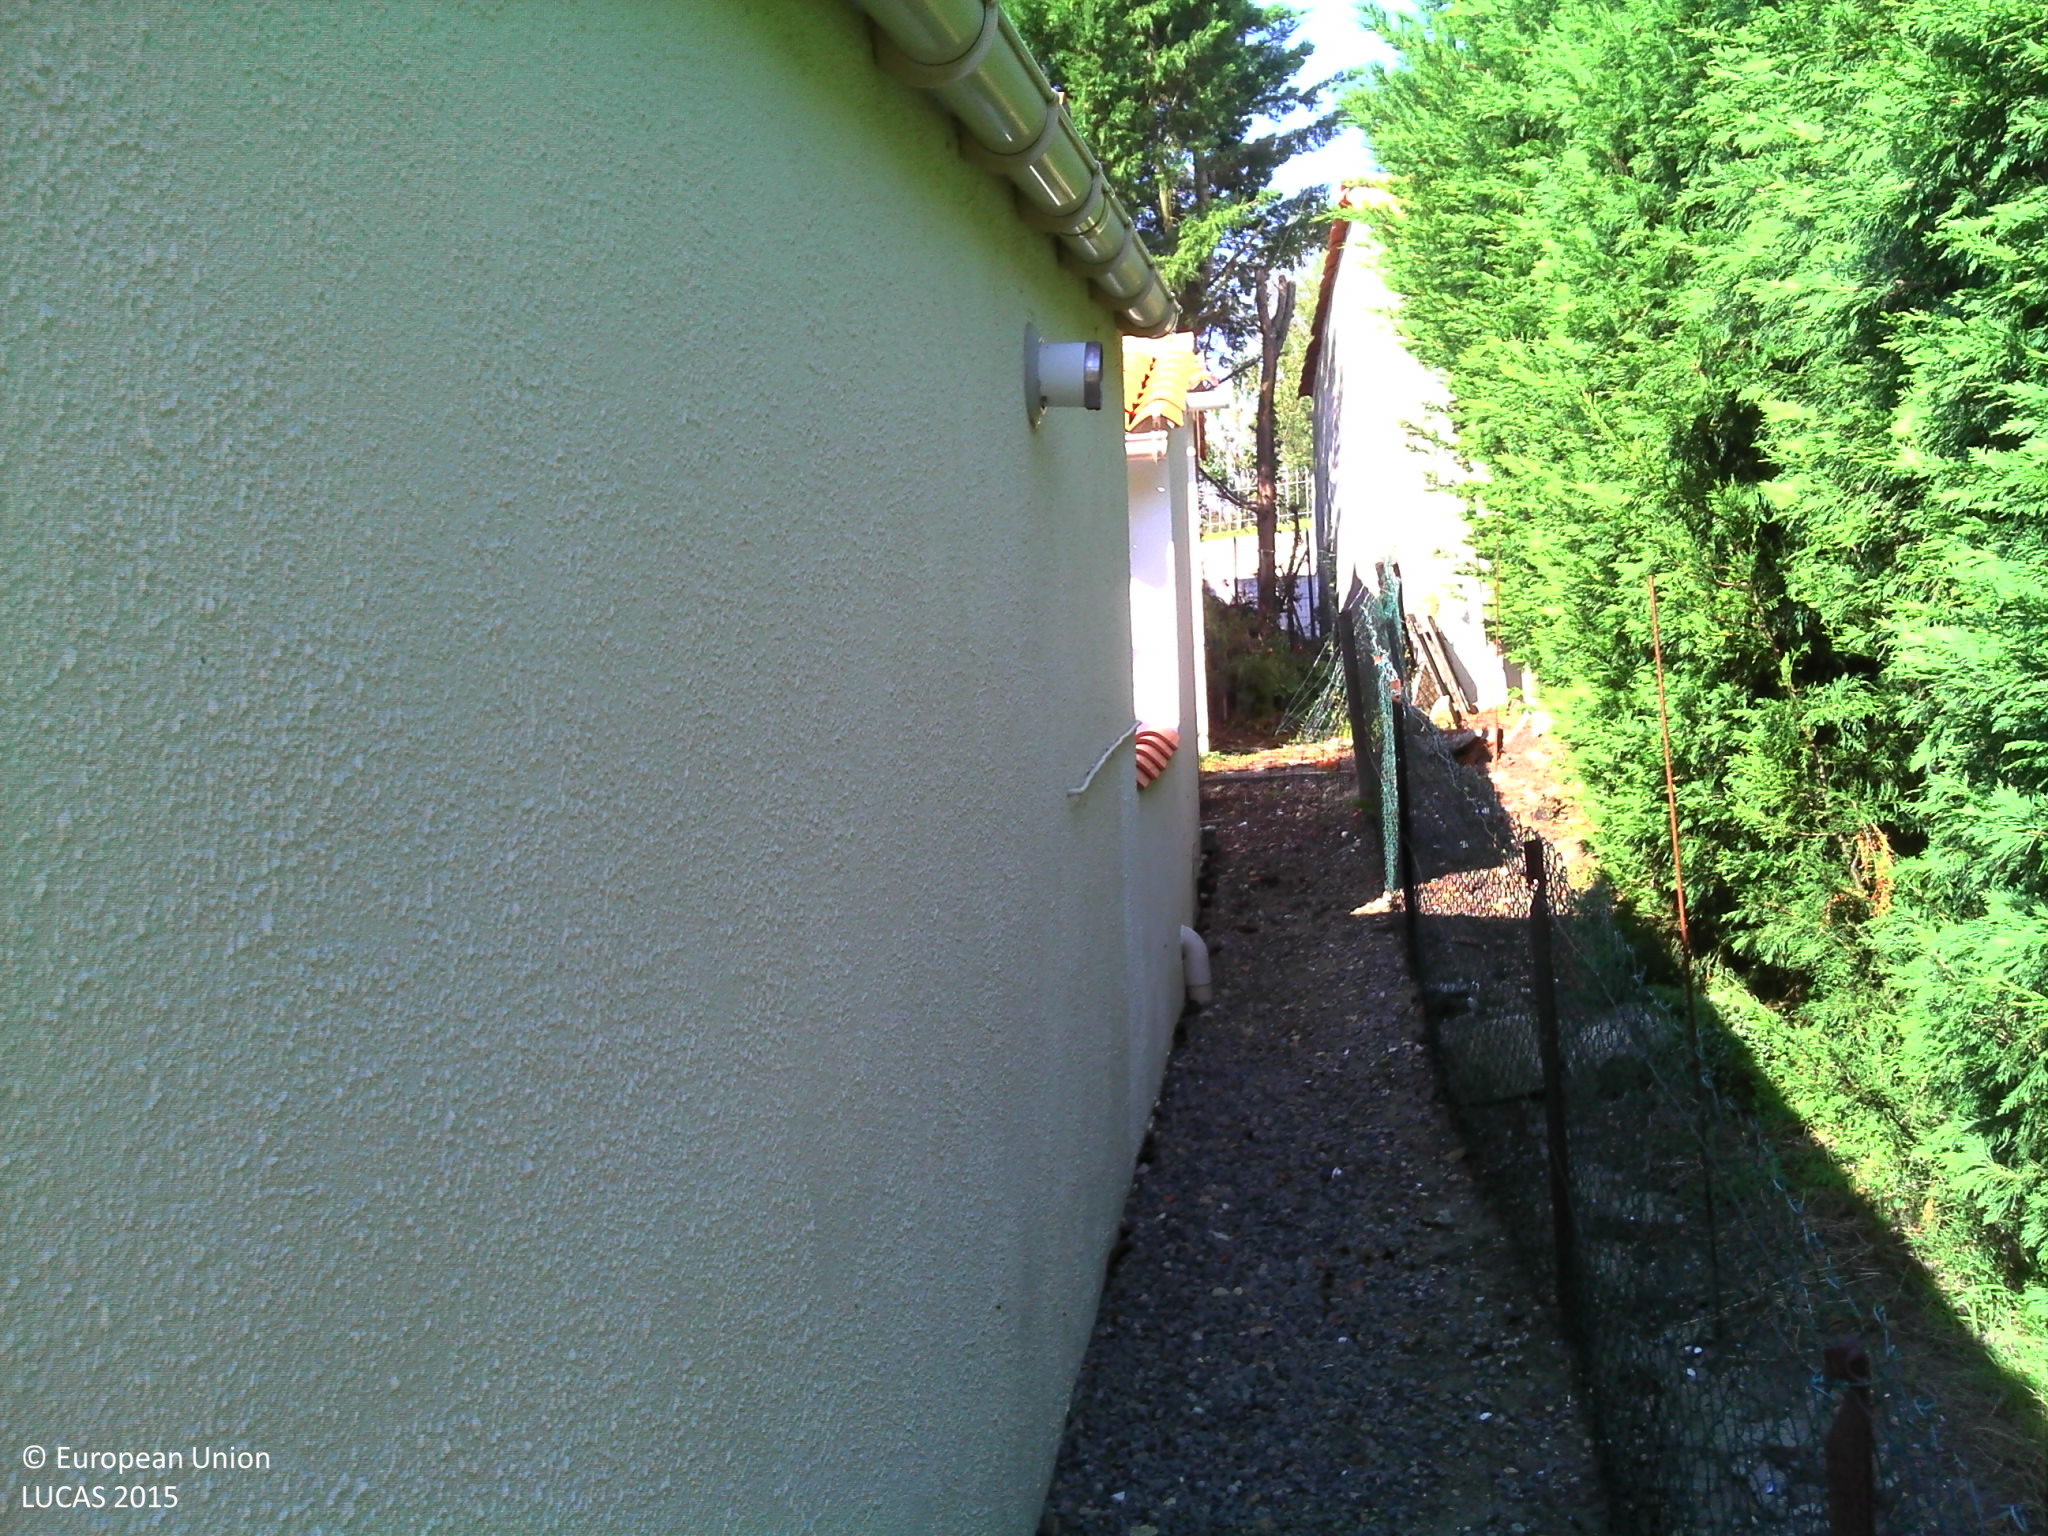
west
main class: Grassland
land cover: Grassland without tree/shrub cover
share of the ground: > 75 %
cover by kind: herbaceous plants 100 %
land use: Residential
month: October
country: FR
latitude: 46.4445
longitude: -1.2684
